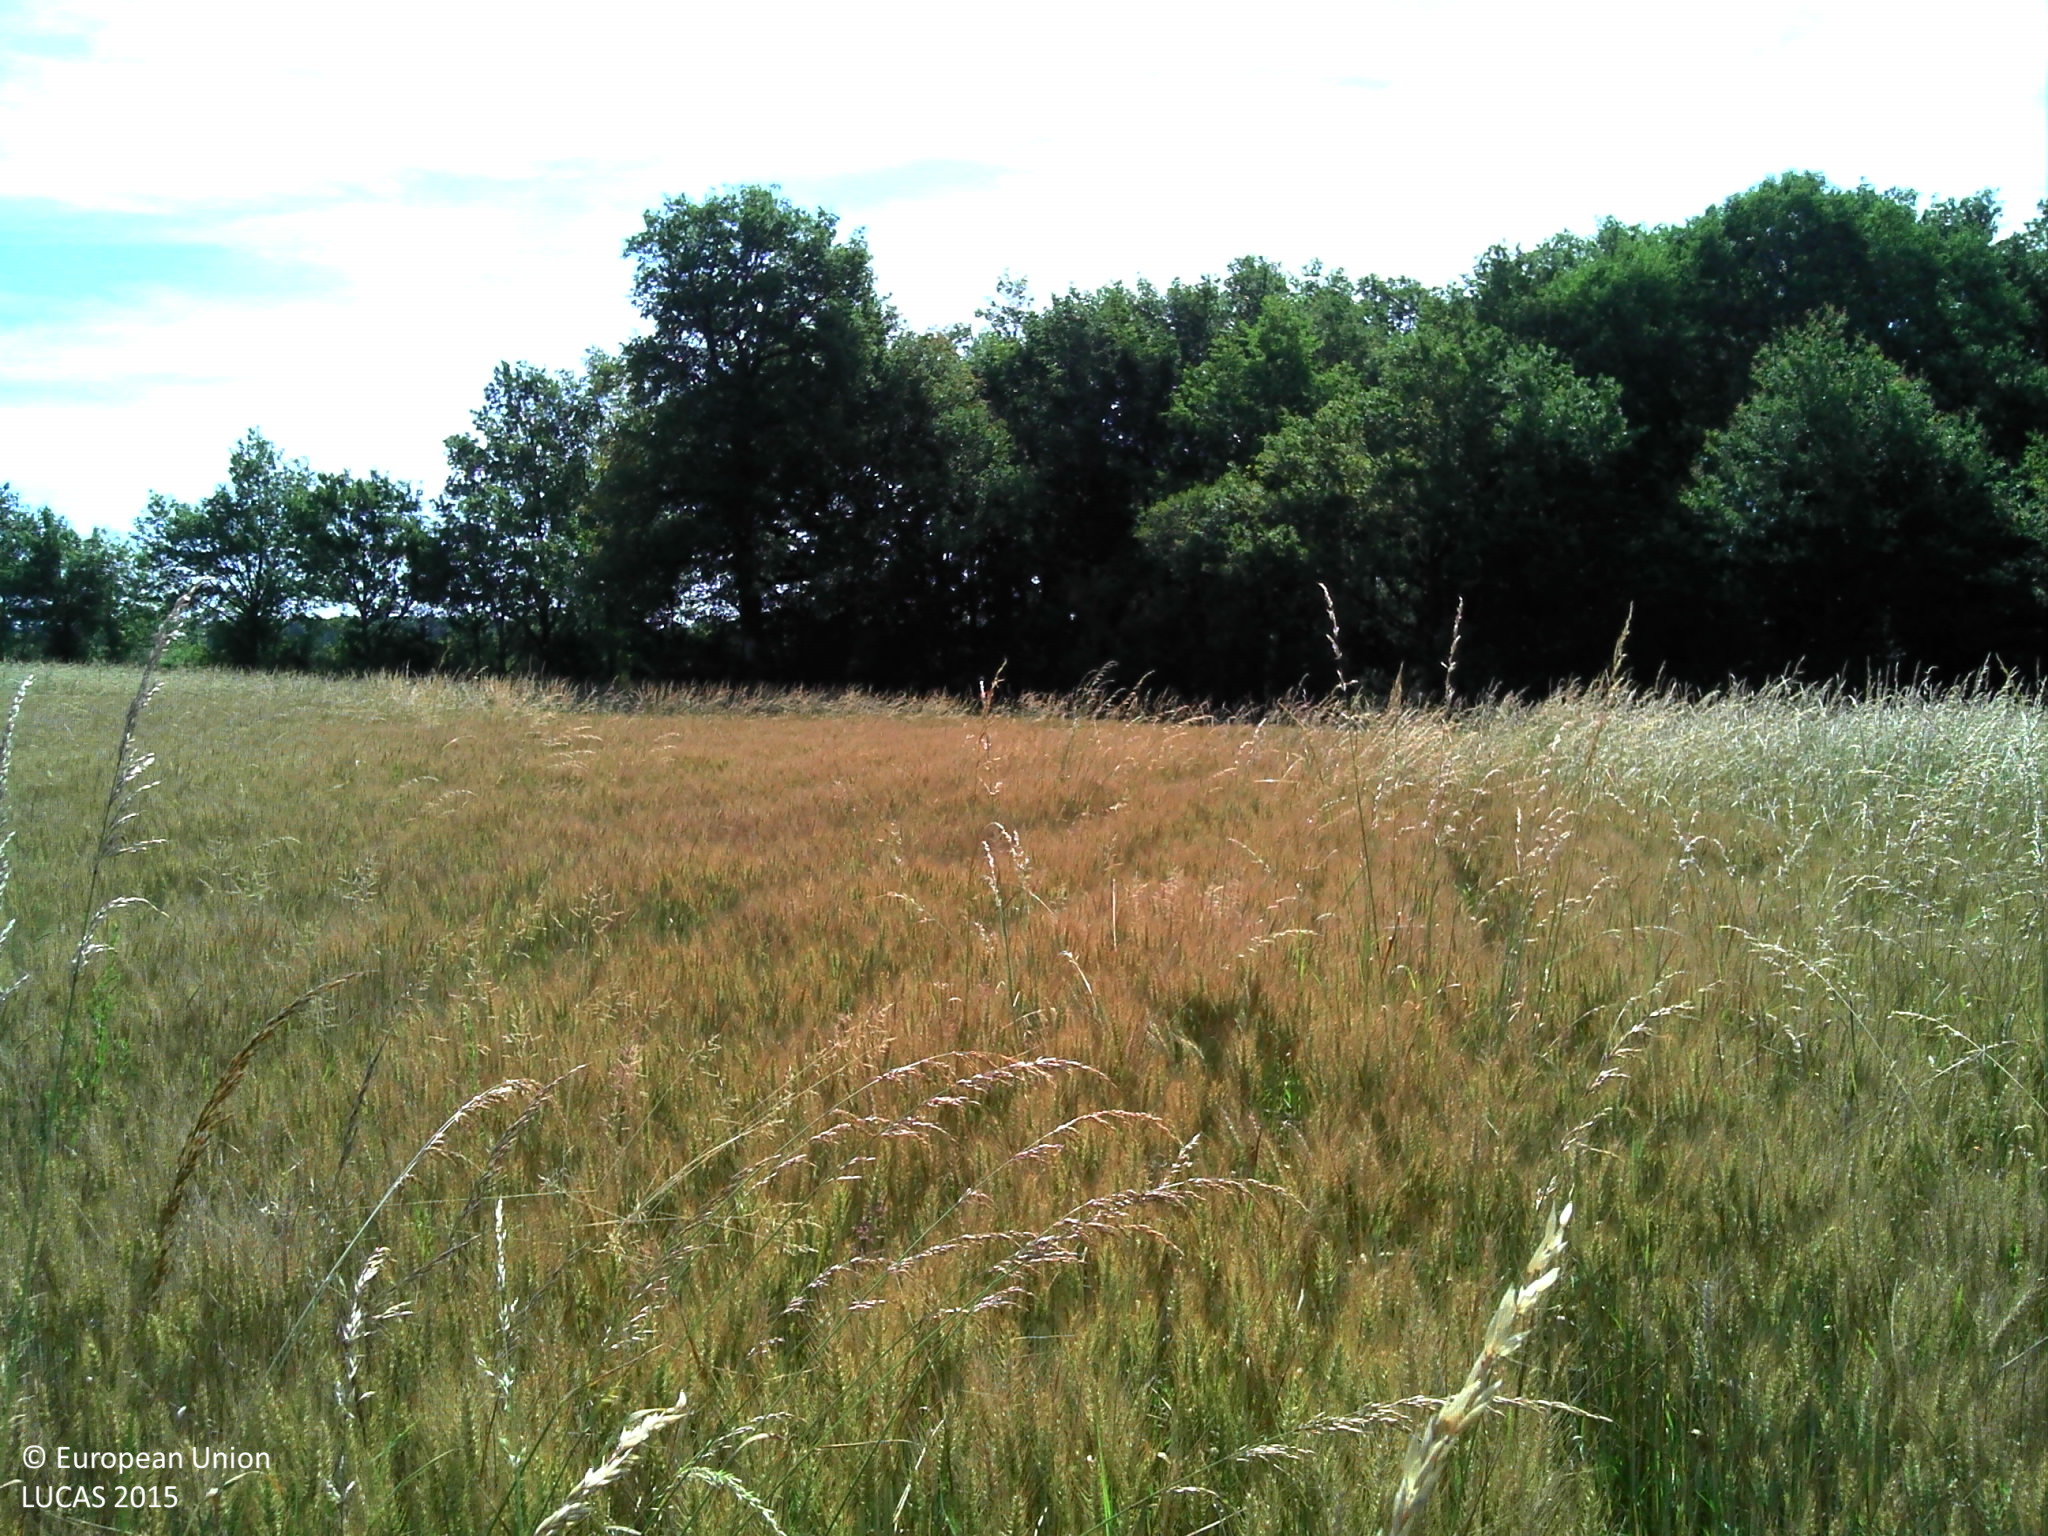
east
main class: Cropland
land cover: Common wheat
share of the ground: > 75 %
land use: Agriculture (excluding fallow land and kitchen gardens)
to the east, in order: Common wheat; Abandoned hedges; Ditches and canals; Tracks; Grass margins; Broadleaved woodland; Grassland without tree/shrub cover; Fences; Managed hedges; Barley
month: June
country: FR
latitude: 44.4954
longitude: 2.0149
